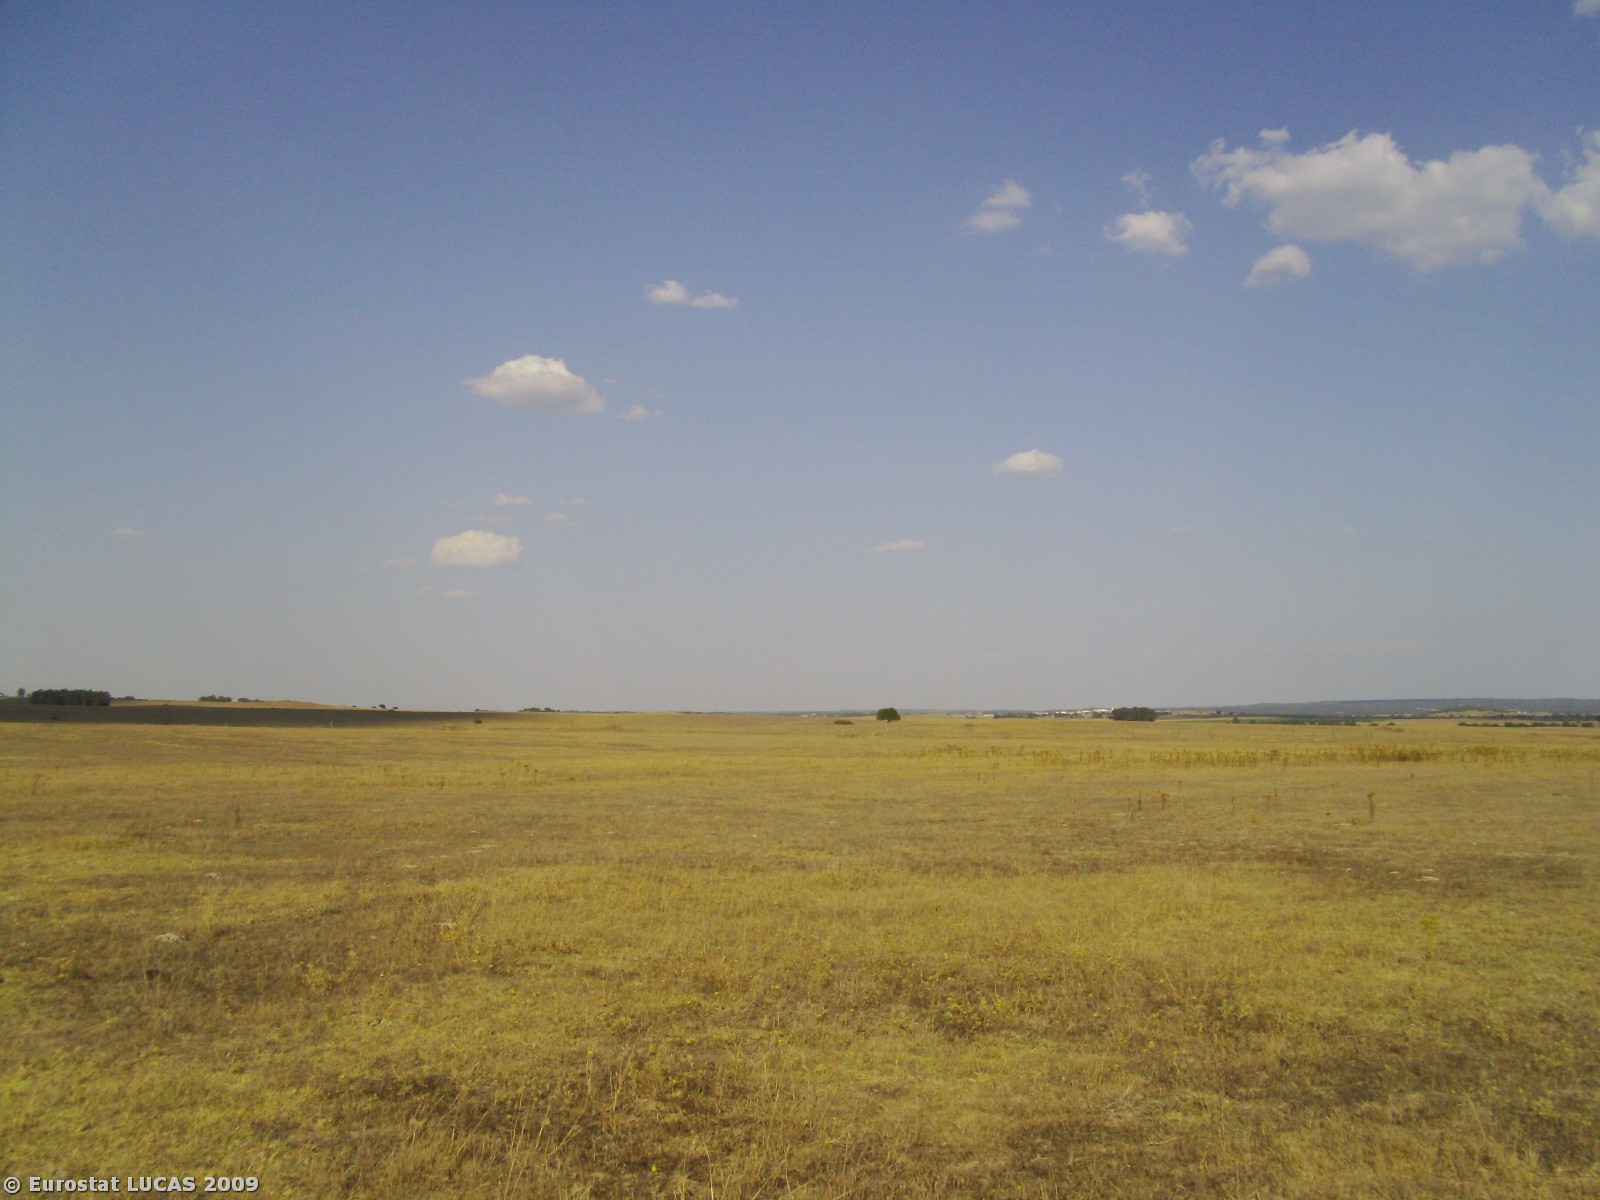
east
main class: Grassland
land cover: Grassland without tree/shrub cover
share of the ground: > 75 %
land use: Agriculture (excluding fallow land and kitchen gardens)
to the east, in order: Grassland without tree/shrub cover; Bare land; Fences; Bare land; Grassland without tree/shrub cover
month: August
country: PT
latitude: 38.3926
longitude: -8.0494
